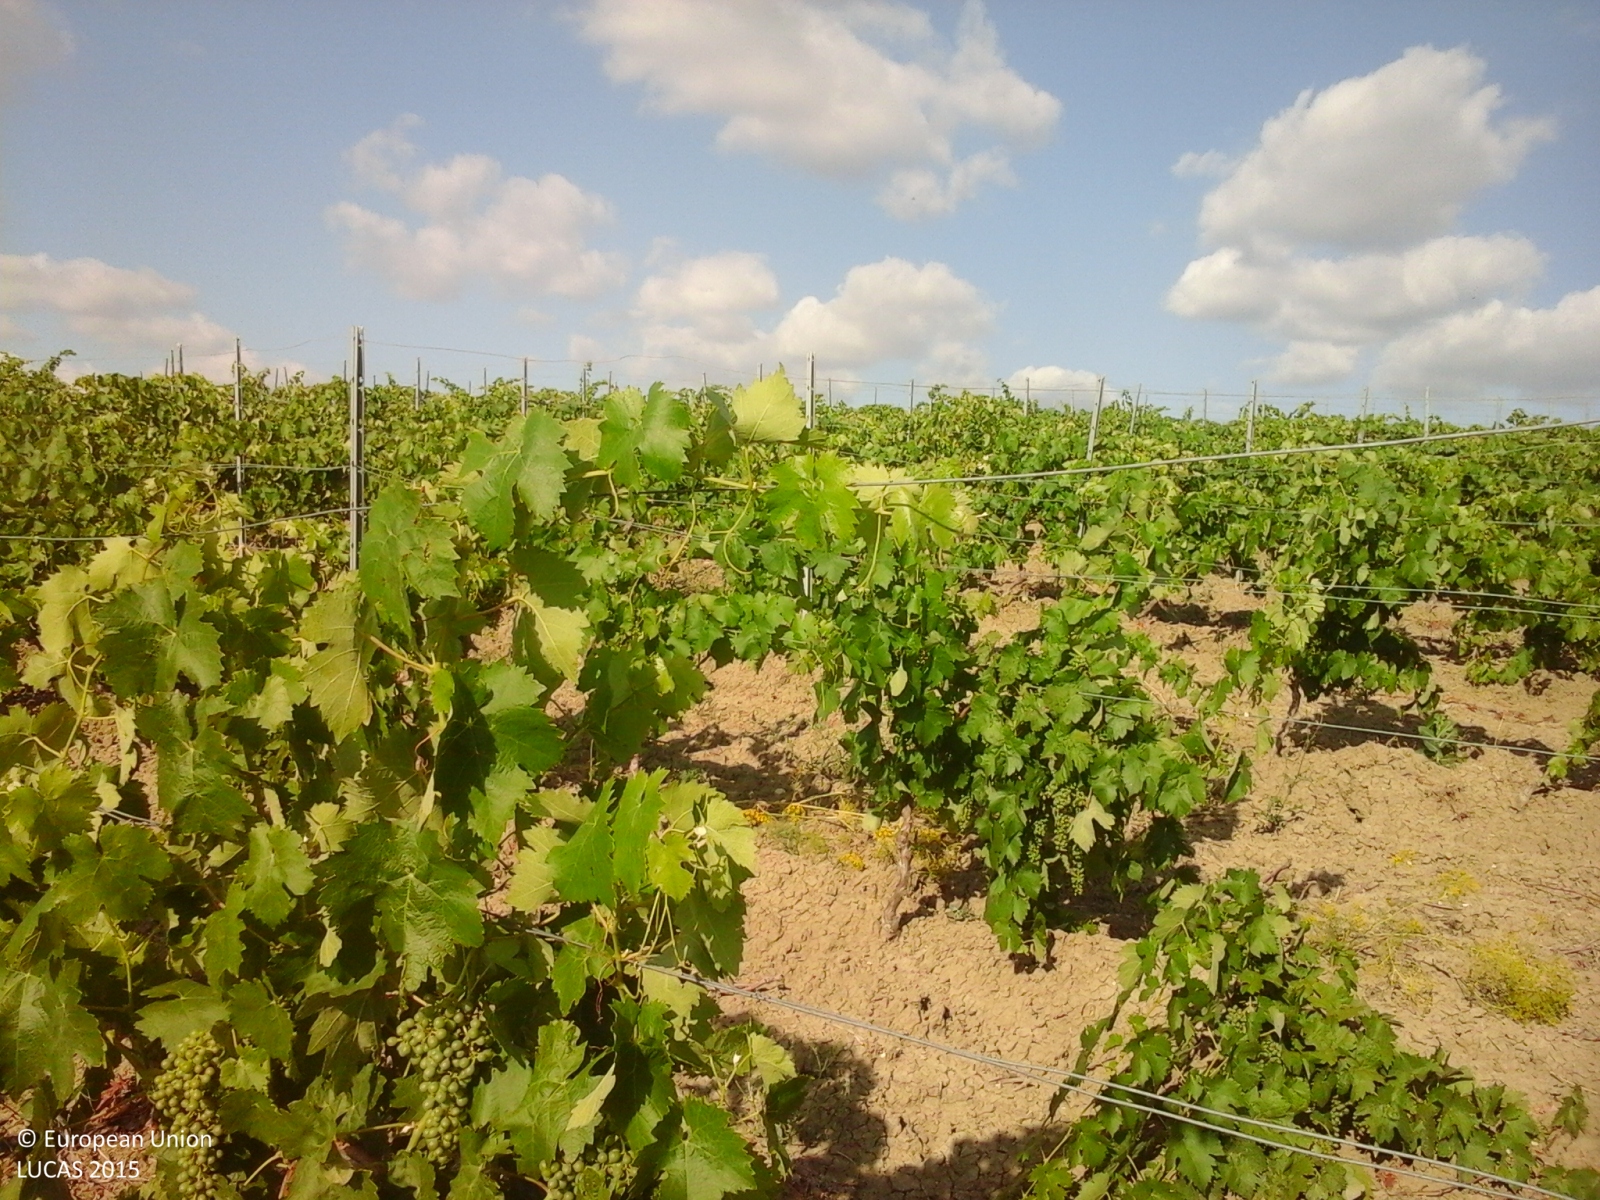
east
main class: Cropland
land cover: Vineyards
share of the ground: 25 - 50 %
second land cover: Other bare soil
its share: > 75 %
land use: Agriculture (excluding fallow land and kitchen gardens)
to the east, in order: Vineyards; Other bare soil; Durum wheat; Other bare soil; Durum wheat; Other bare soil; Vineyards
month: June
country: IT
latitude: 37.6979
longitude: 13.0732
